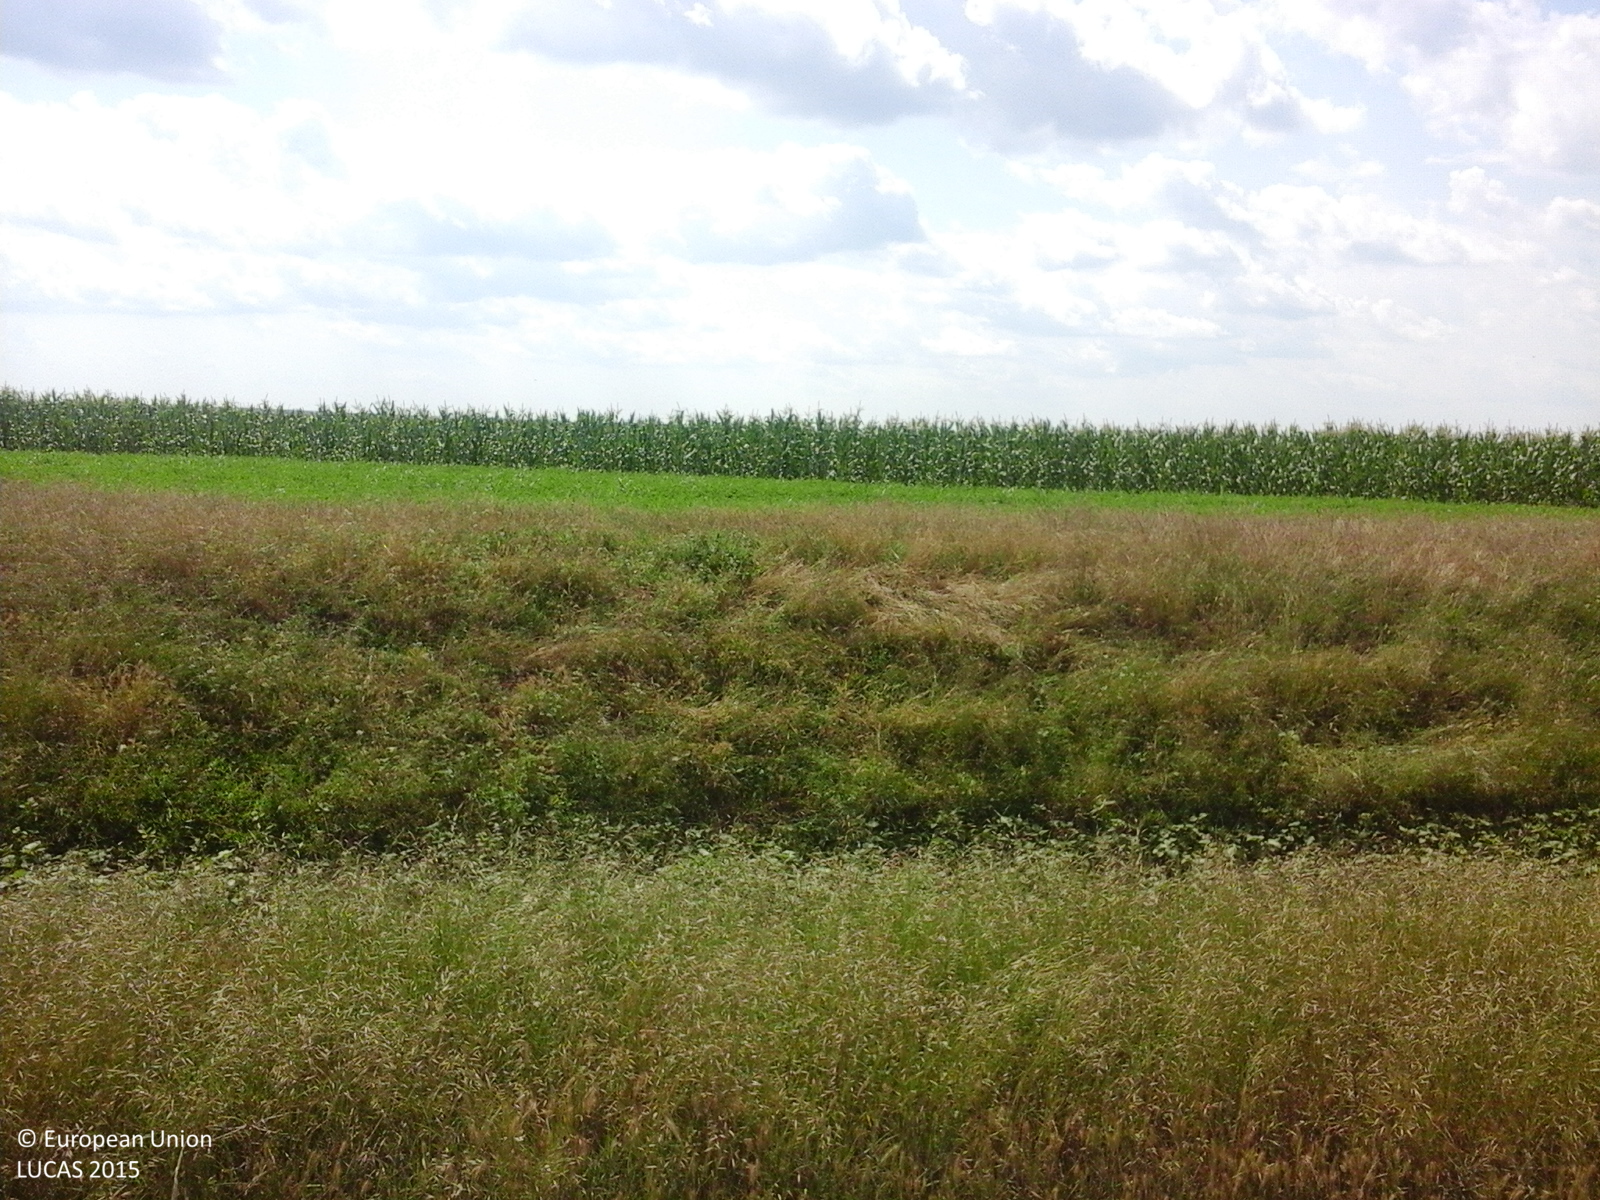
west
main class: Cropland
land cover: Sunflower
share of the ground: > 75 %
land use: Agriculture (excluding fallow land and kitchen gardens)
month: July
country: RO
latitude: 43.8230
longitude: 24.3486
